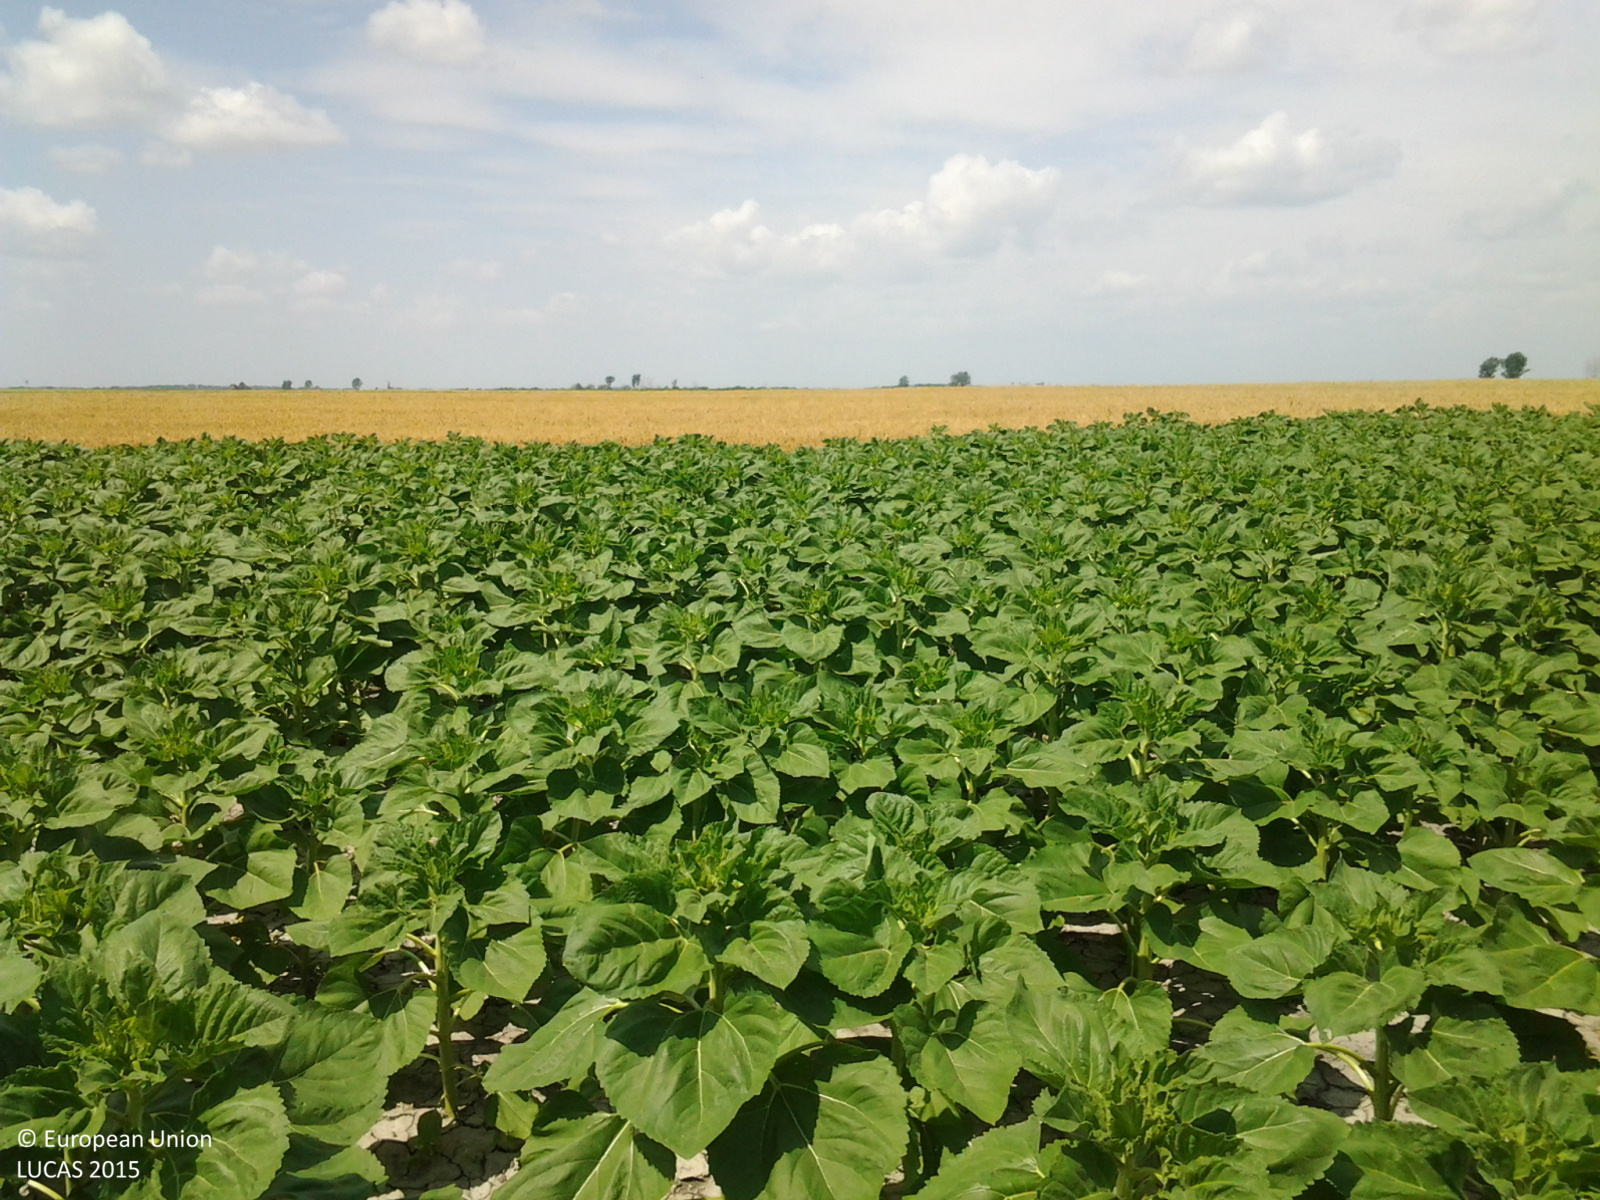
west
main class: Cropland
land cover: Sunflower
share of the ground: > 75 %
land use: Agriculture (excluding fallow land and kitchen gardens)
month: June
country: HU
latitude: 46.5644
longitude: 19.0549
